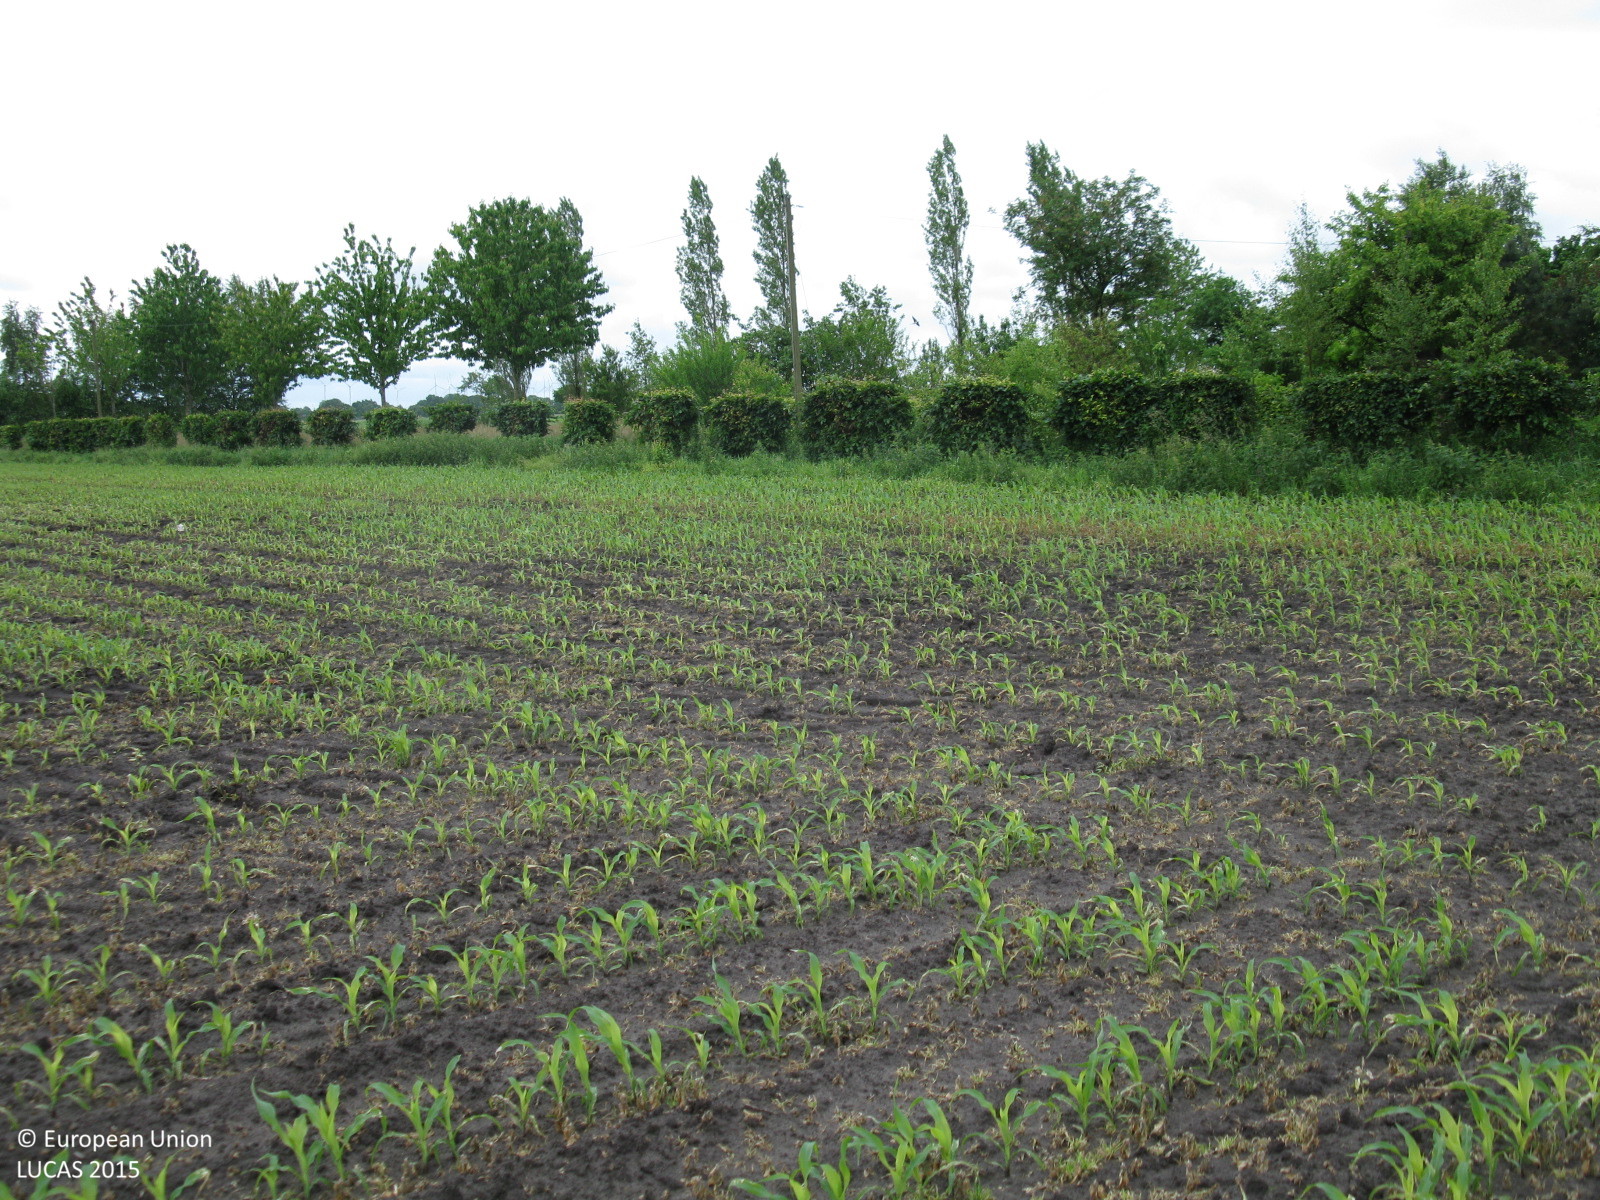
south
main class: Cropland
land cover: Maize
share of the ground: 10 - 25 %
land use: Agriculture (excluding fallow land and kitchen gardens)
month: June
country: DE
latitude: 53.4452
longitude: 7.3658
